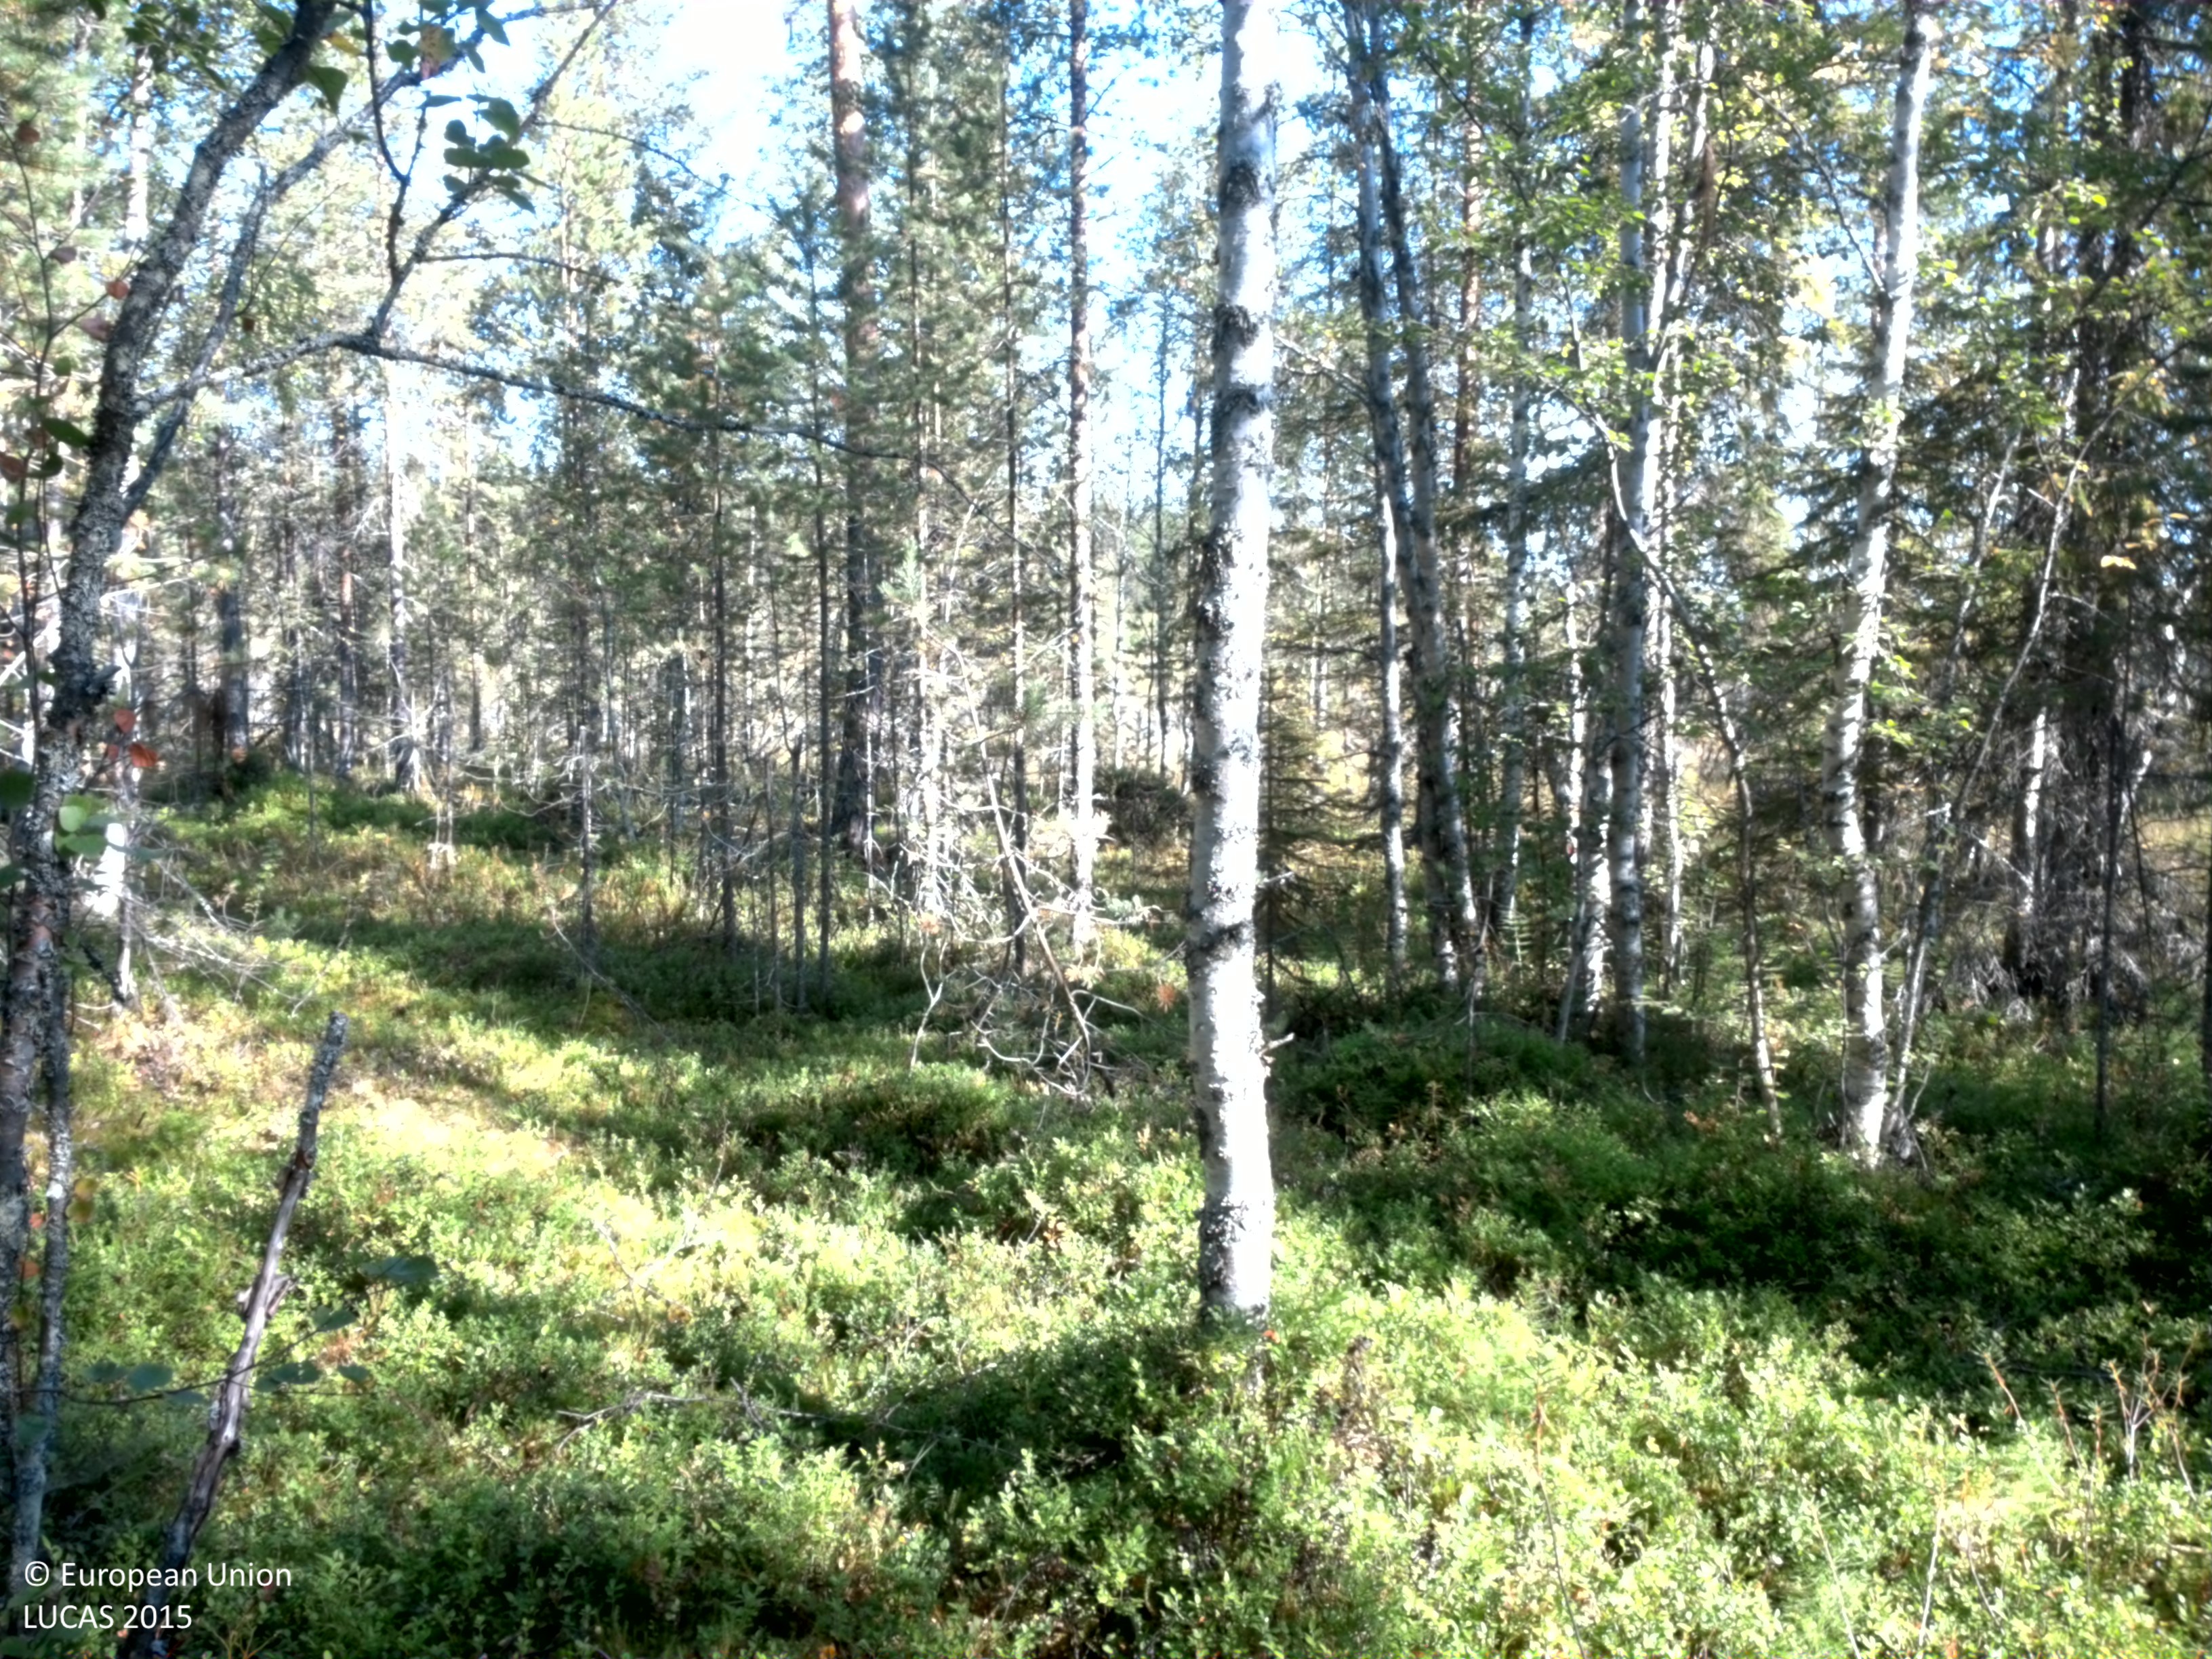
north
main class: Woodland
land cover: Pine dominated mixed woodland
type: boreal forest
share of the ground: 50 - 75 %
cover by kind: coniferous forest trees 45 %, shrubs 35 %, broadleaved forest trees 15 %, lichens and mosses 5 %
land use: Forestry
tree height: > 5 m
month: August
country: SE
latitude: 64.5497
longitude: 18.8746
